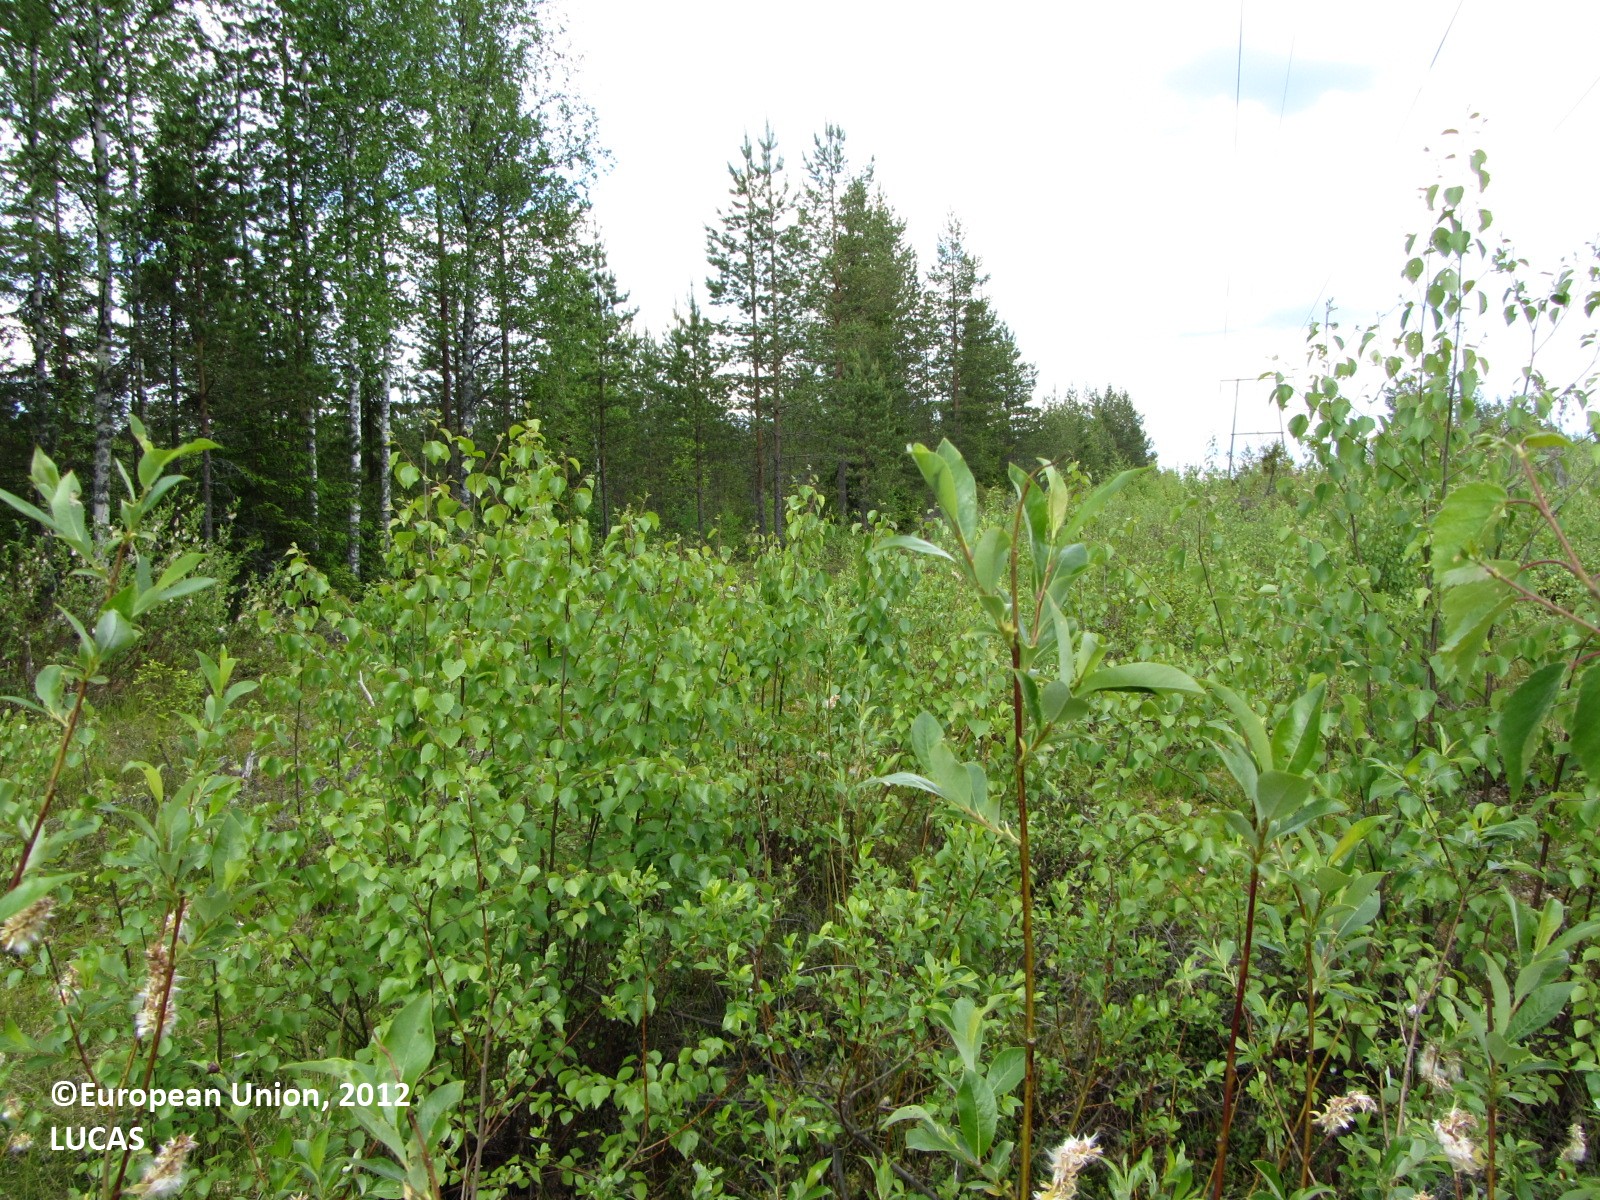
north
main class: Woodland
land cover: Broadleaved woodland
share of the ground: 25 - 50 %
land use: Energy production
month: June
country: FI
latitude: 62.2768
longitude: 25.1942
